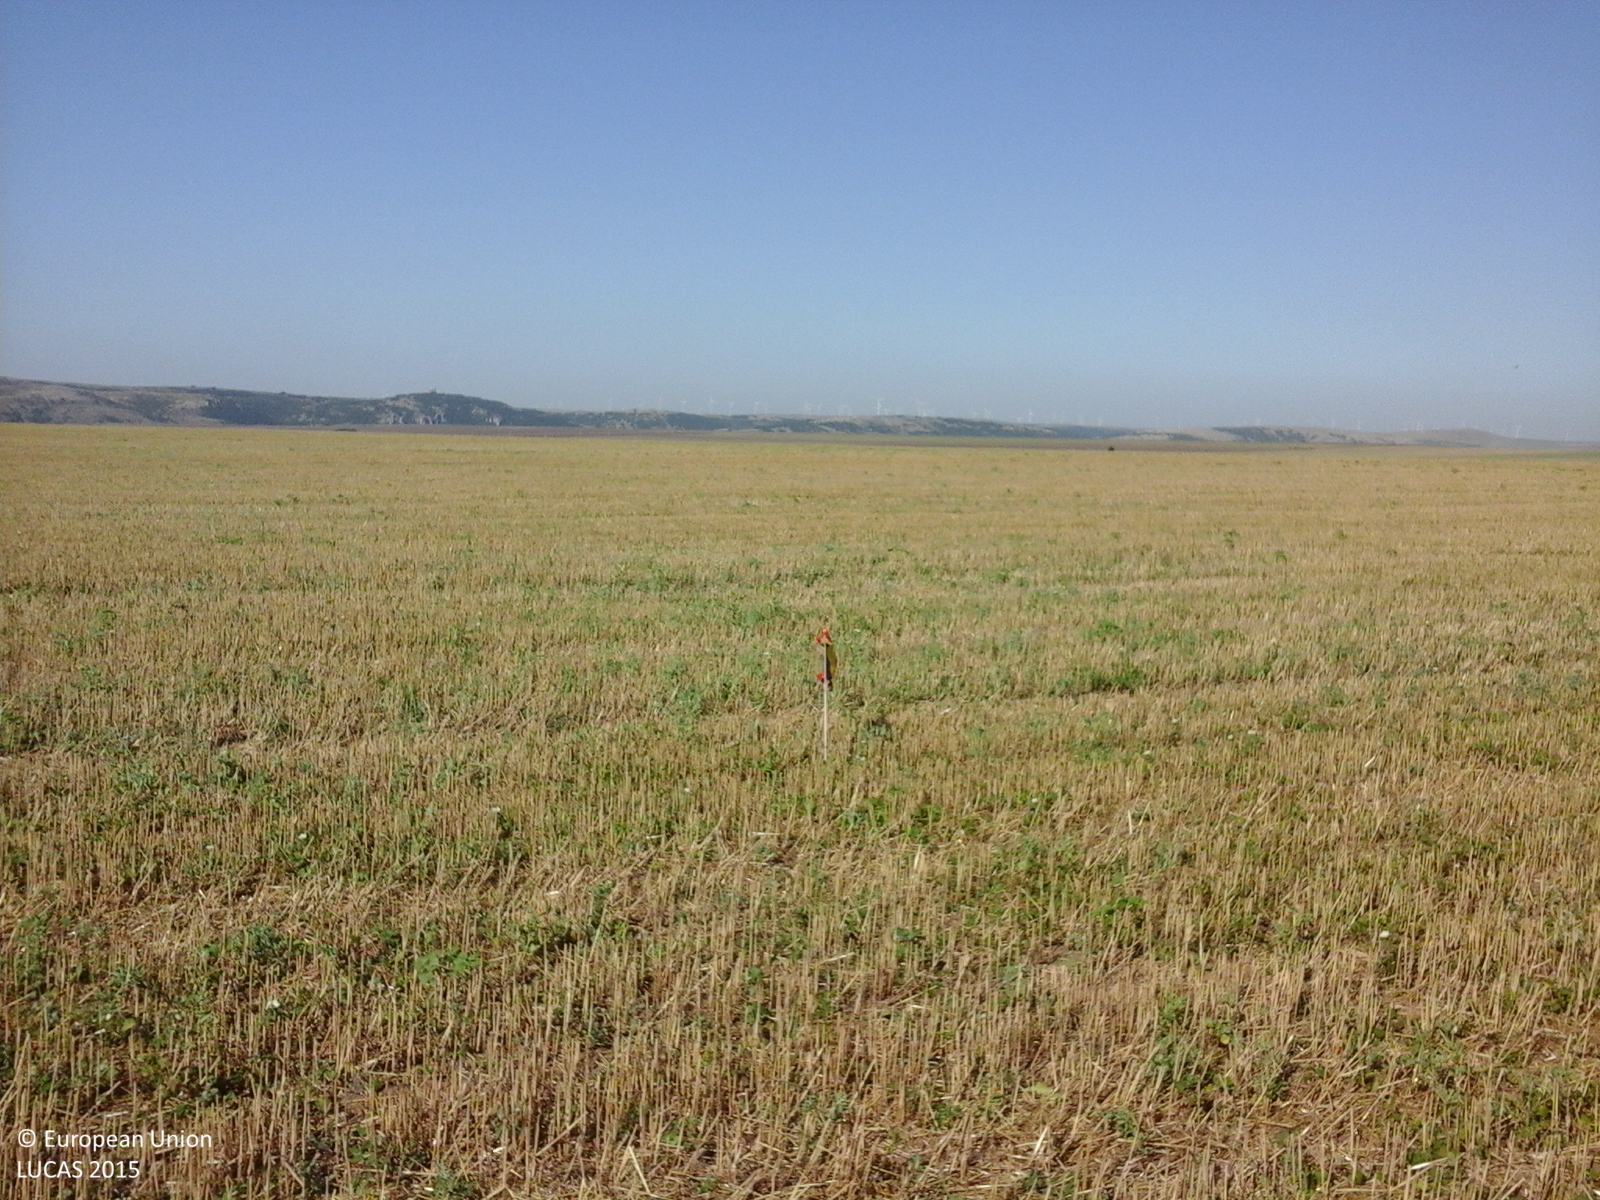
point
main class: Cropland
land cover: Common wheat
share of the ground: > 75 %
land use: Agriculture (excluding fallow land and kitchen gardens)
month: August
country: RO
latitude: 44.5152
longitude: 28.5035
